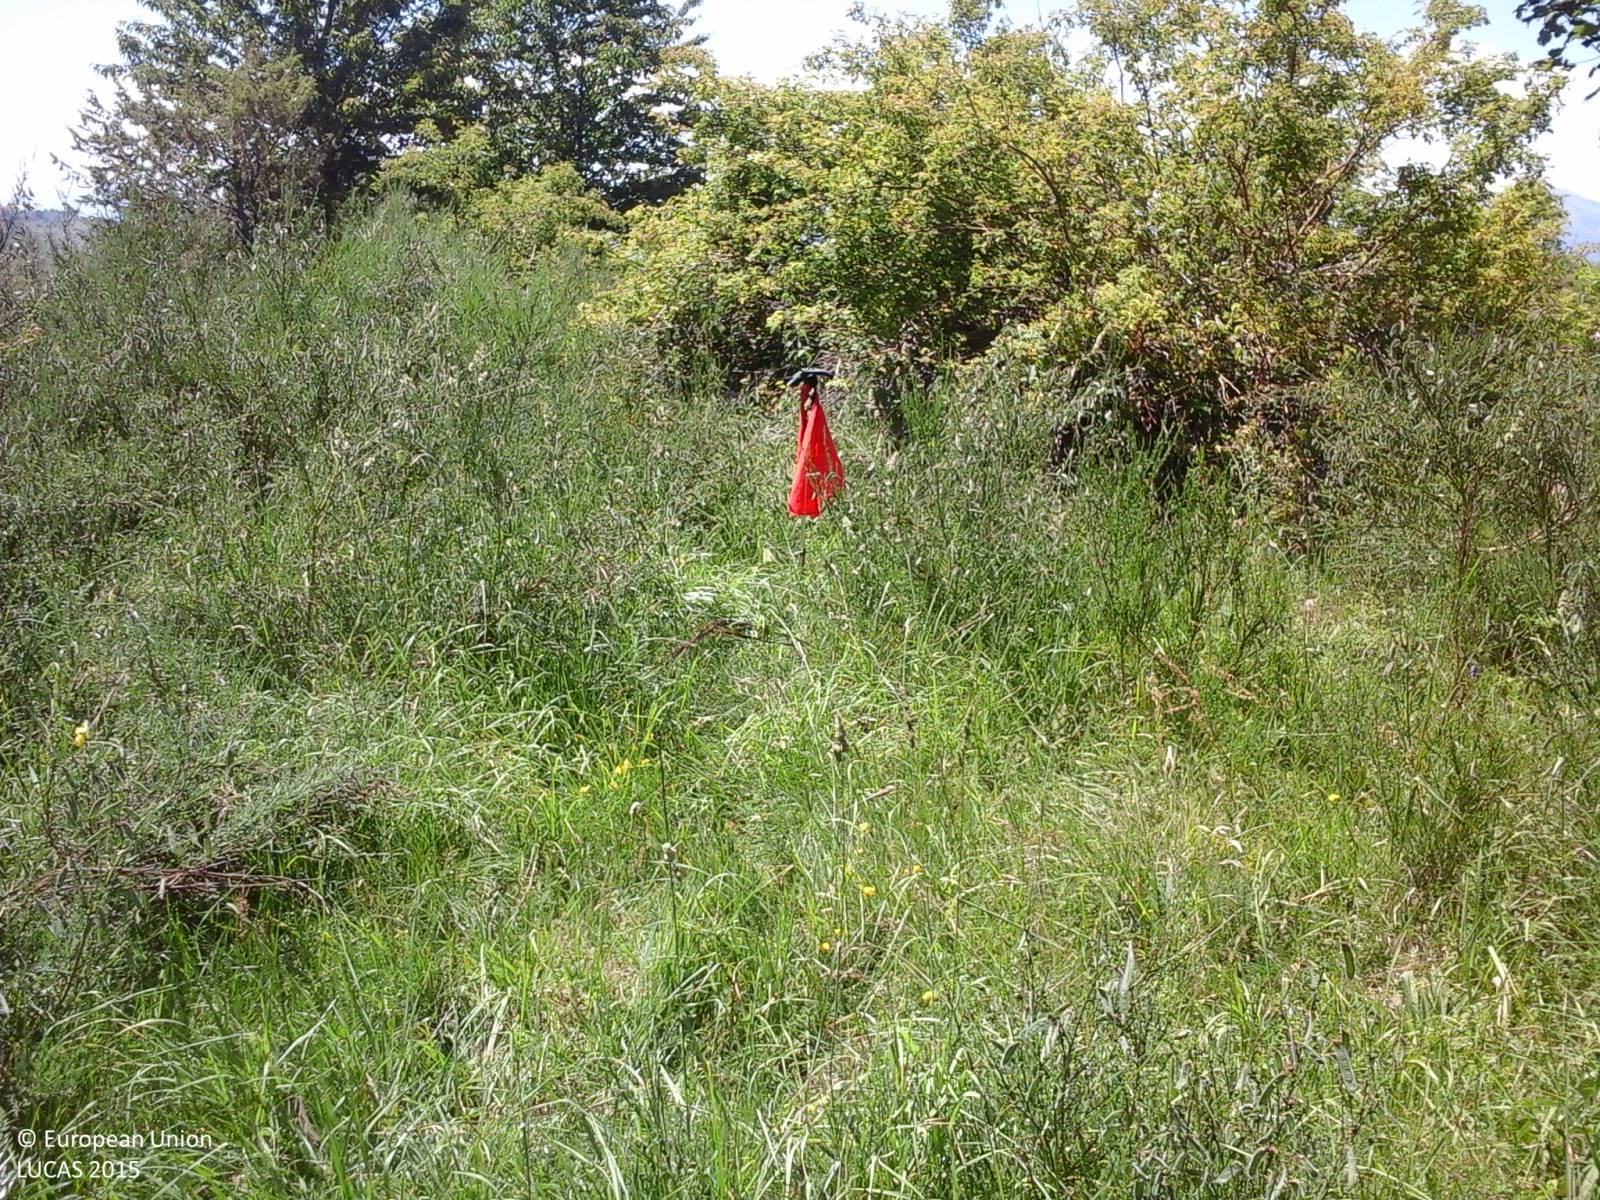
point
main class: Shrubland
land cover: Shrubland with sparse tree cover
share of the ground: > 75 %
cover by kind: shrubs 60 %, herbaceous plants 35 %, broadleaved forest trees 5 %
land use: Semi-natural and natural areas not in use
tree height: > 5 m
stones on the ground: < 10 %
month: July
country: IT
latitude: 42.5628
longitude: 13.3394
